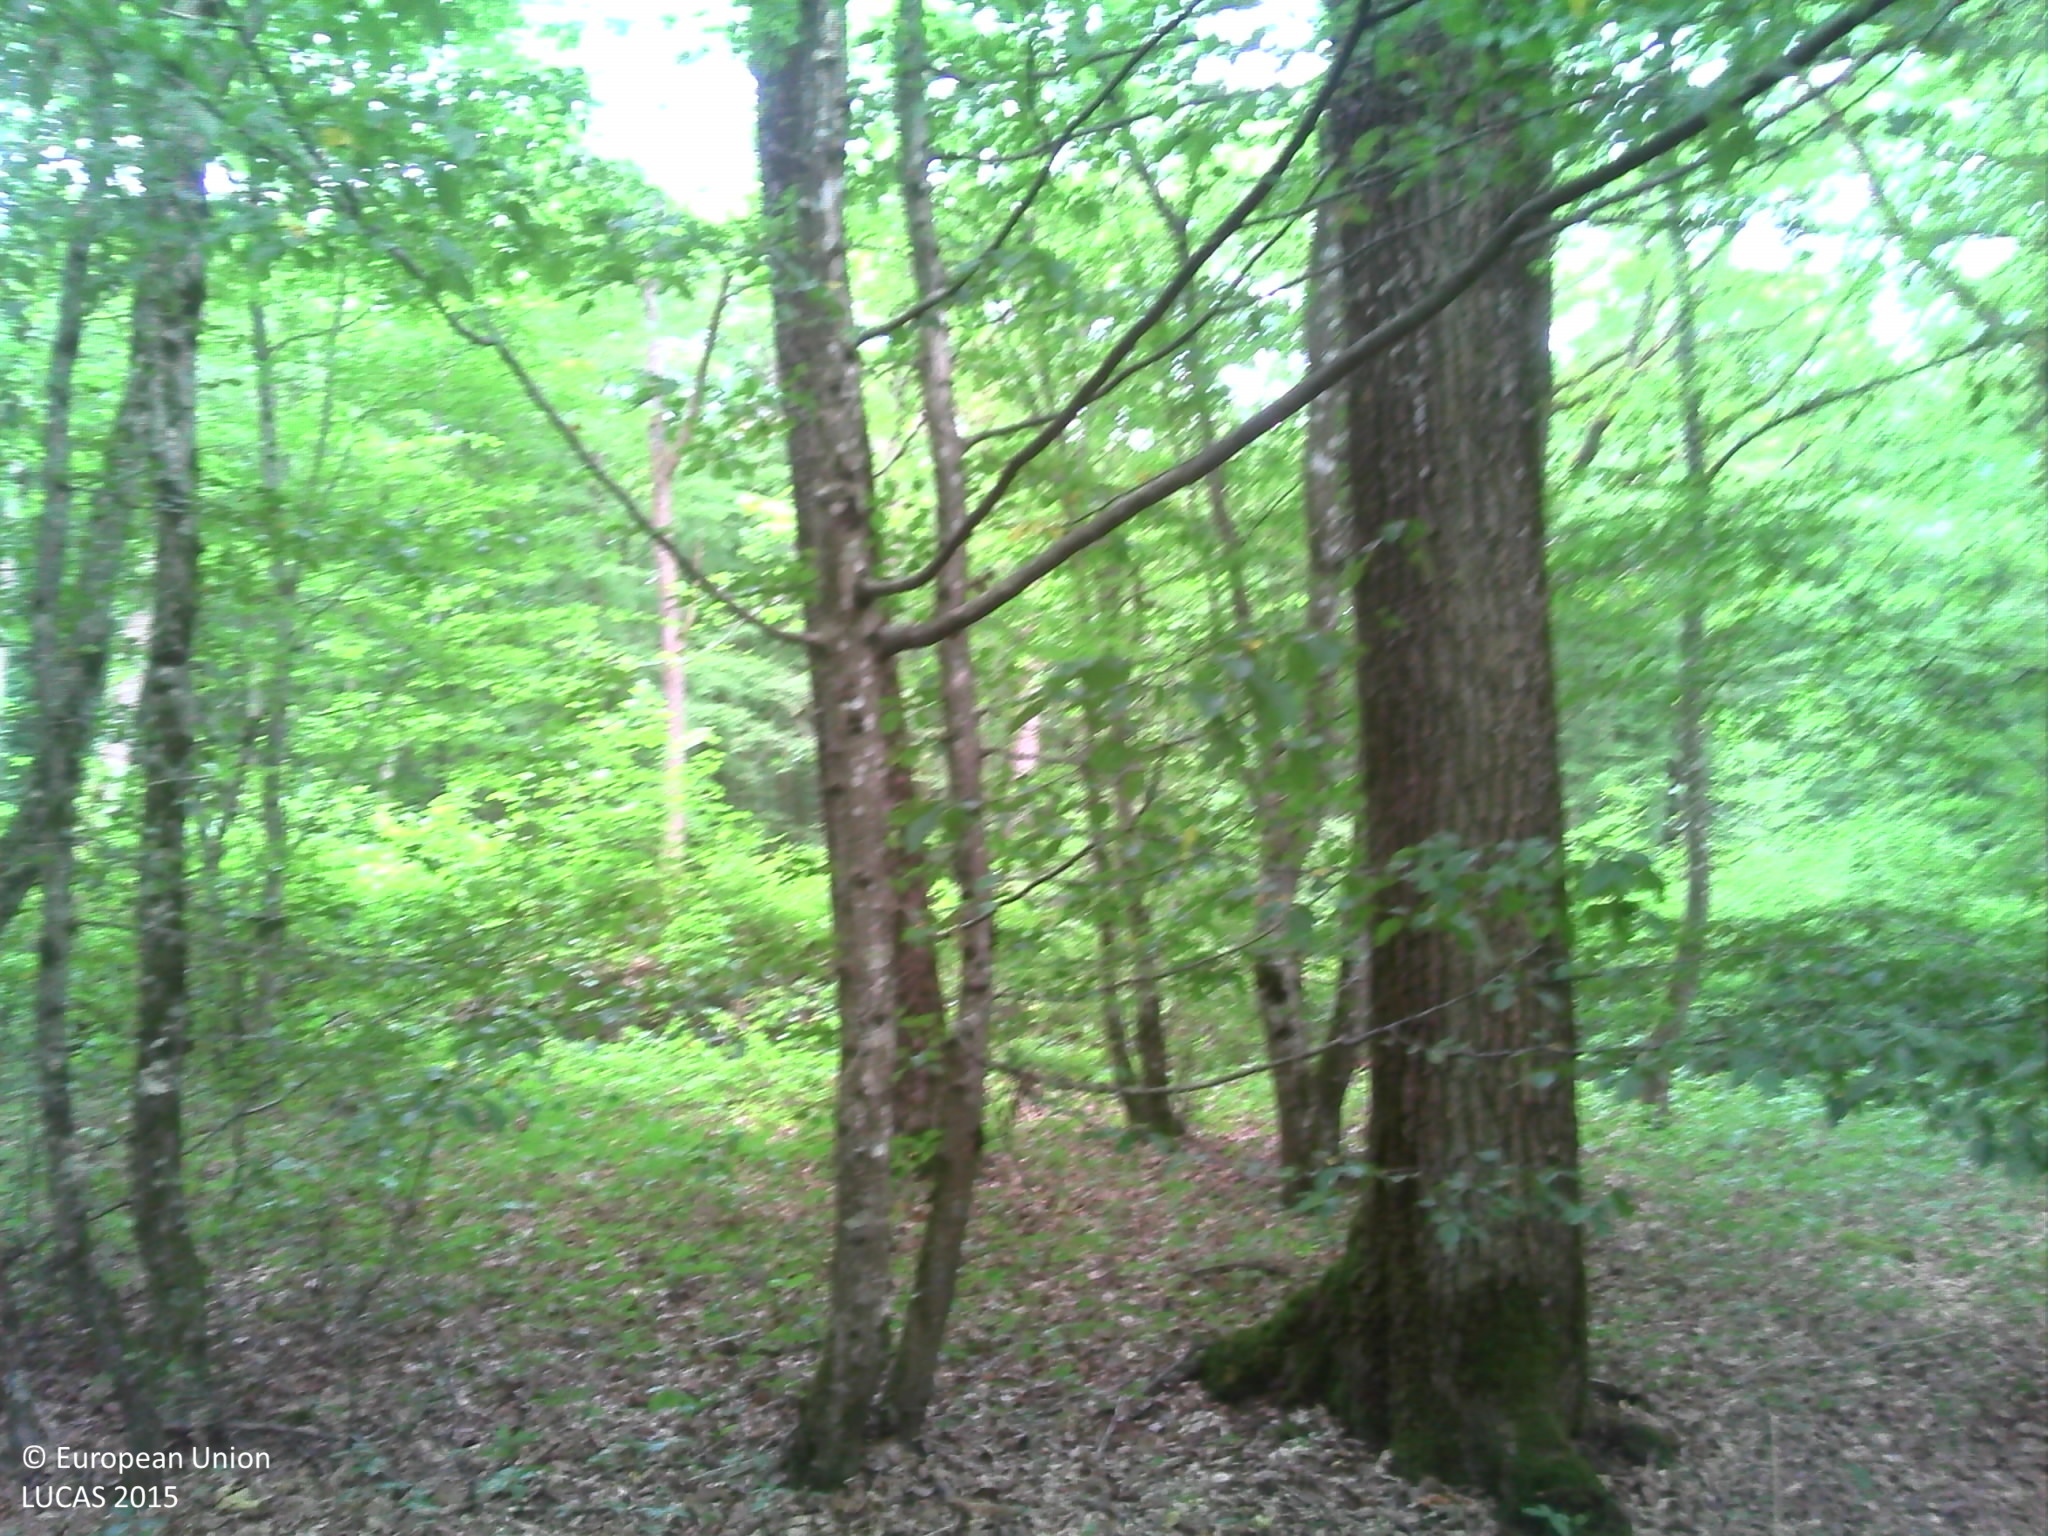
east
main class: Woodland
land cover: Broadleaved woodland
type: mesophytic deciduous forest
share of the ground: > 75 %
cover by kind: broadleaved forest trees 100 %
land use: Forestry
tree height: > 5 m
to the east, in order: Broadleaved woodland; Ditches and canals; Grass margins; Paved roads, cycling and walking lanes; Grass margins; Ditches and canals; Broadleaved woodland; Ditches and canals; Broadleaved woodland; Ditches and canals; Grass margins; Tracks; Grass margins; Ditches and canals; Fences; Broadleaved woodland
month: August
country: FR
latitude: 48.0236
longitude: 2.0095
